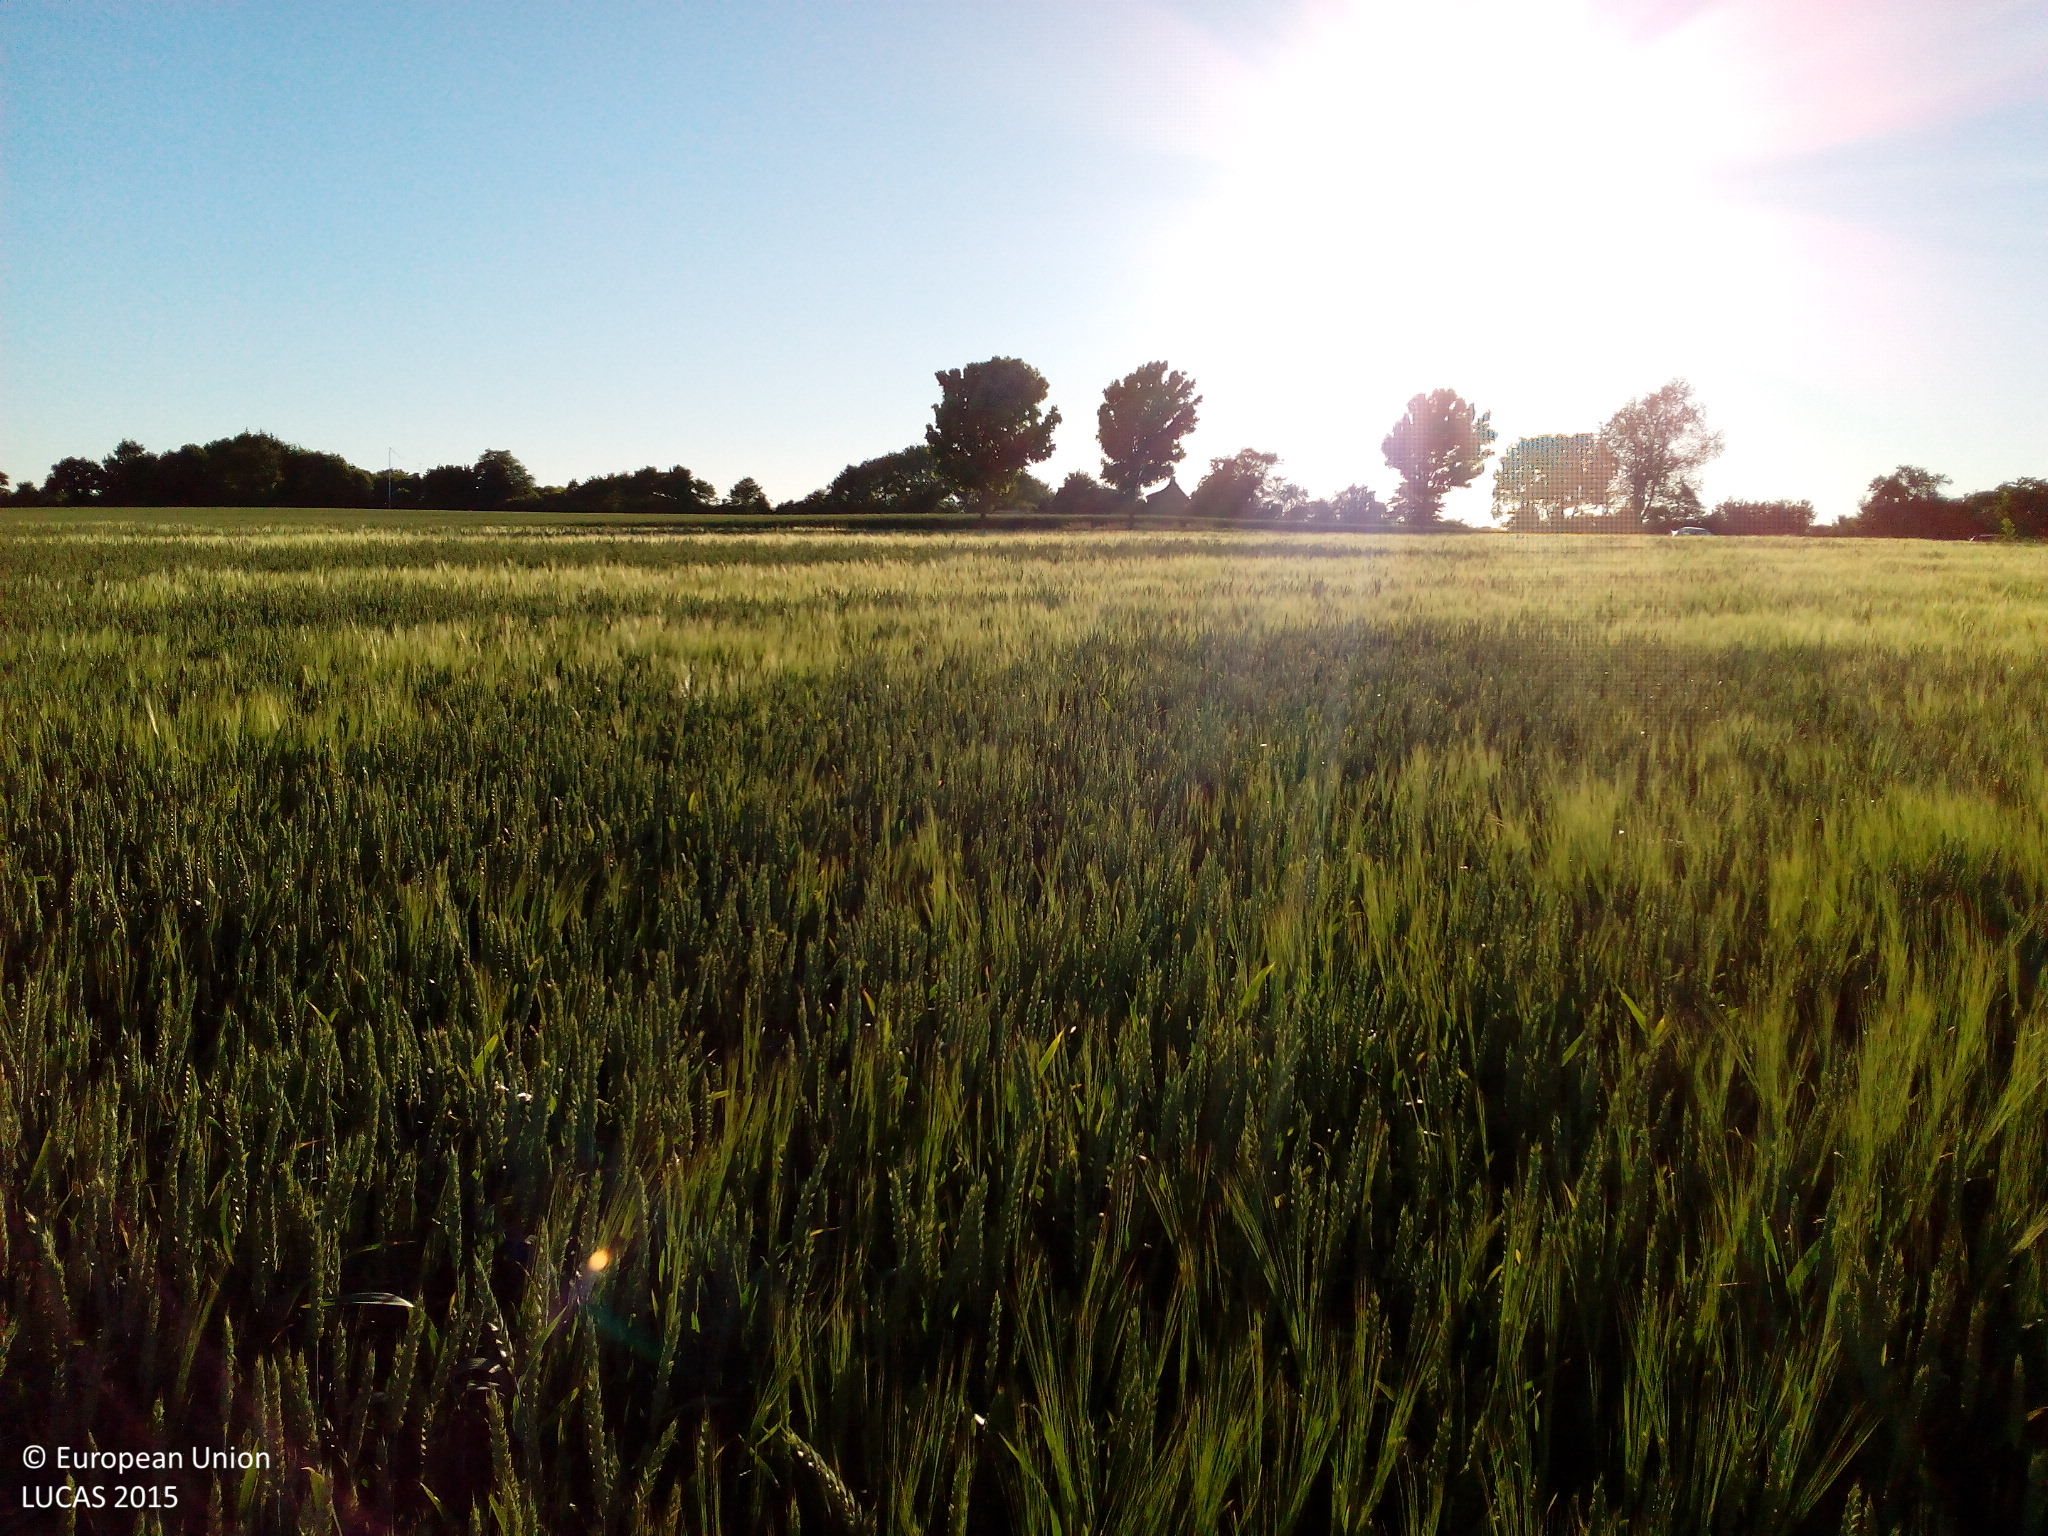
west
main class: Cropland
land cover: Common wheat
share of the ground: > 75 %
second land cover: Barley
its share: 50 - 75 %
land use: Agriculture (excluding fallow land and kitchen gardens)
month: July
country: DK
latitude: 55.1998
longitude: 12.0881
